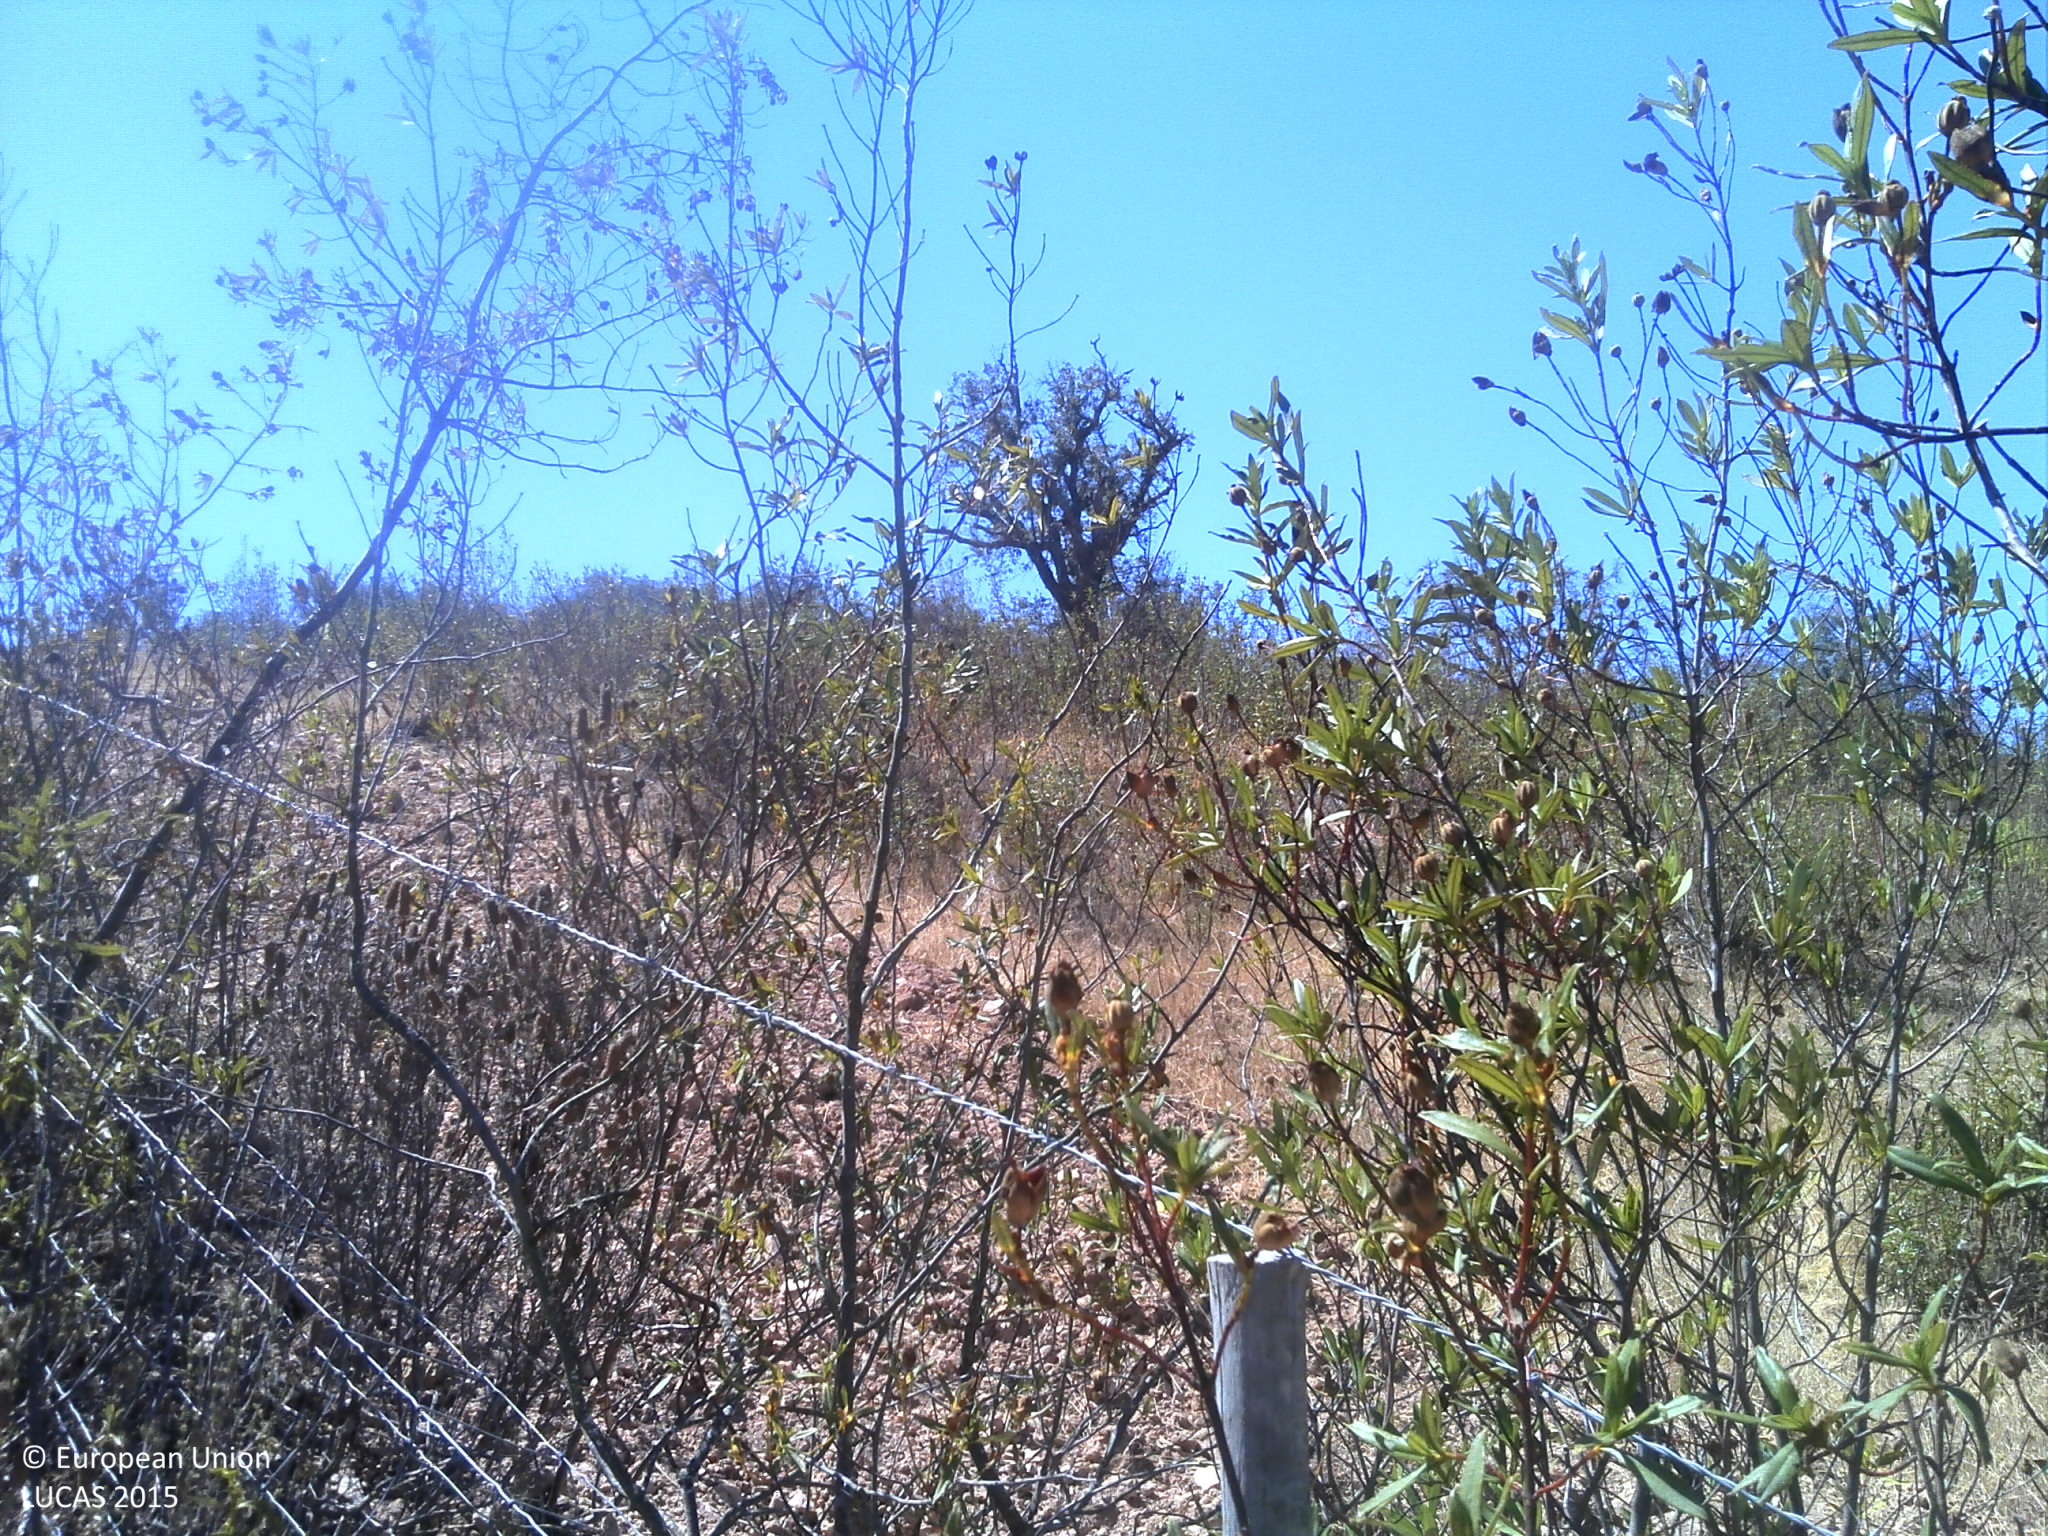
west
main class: Woodland
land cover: Broadleaved woodland
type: broadleaved evergreen forest
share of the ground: 10 - 25 %
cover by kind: unconsolidated bare surface 70 %, broadleaved forest trees 15 %, shrubs 15 %
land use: Forestry
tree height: < 5 m
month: August
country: PT
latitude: 37.4938
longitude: -8.2011
